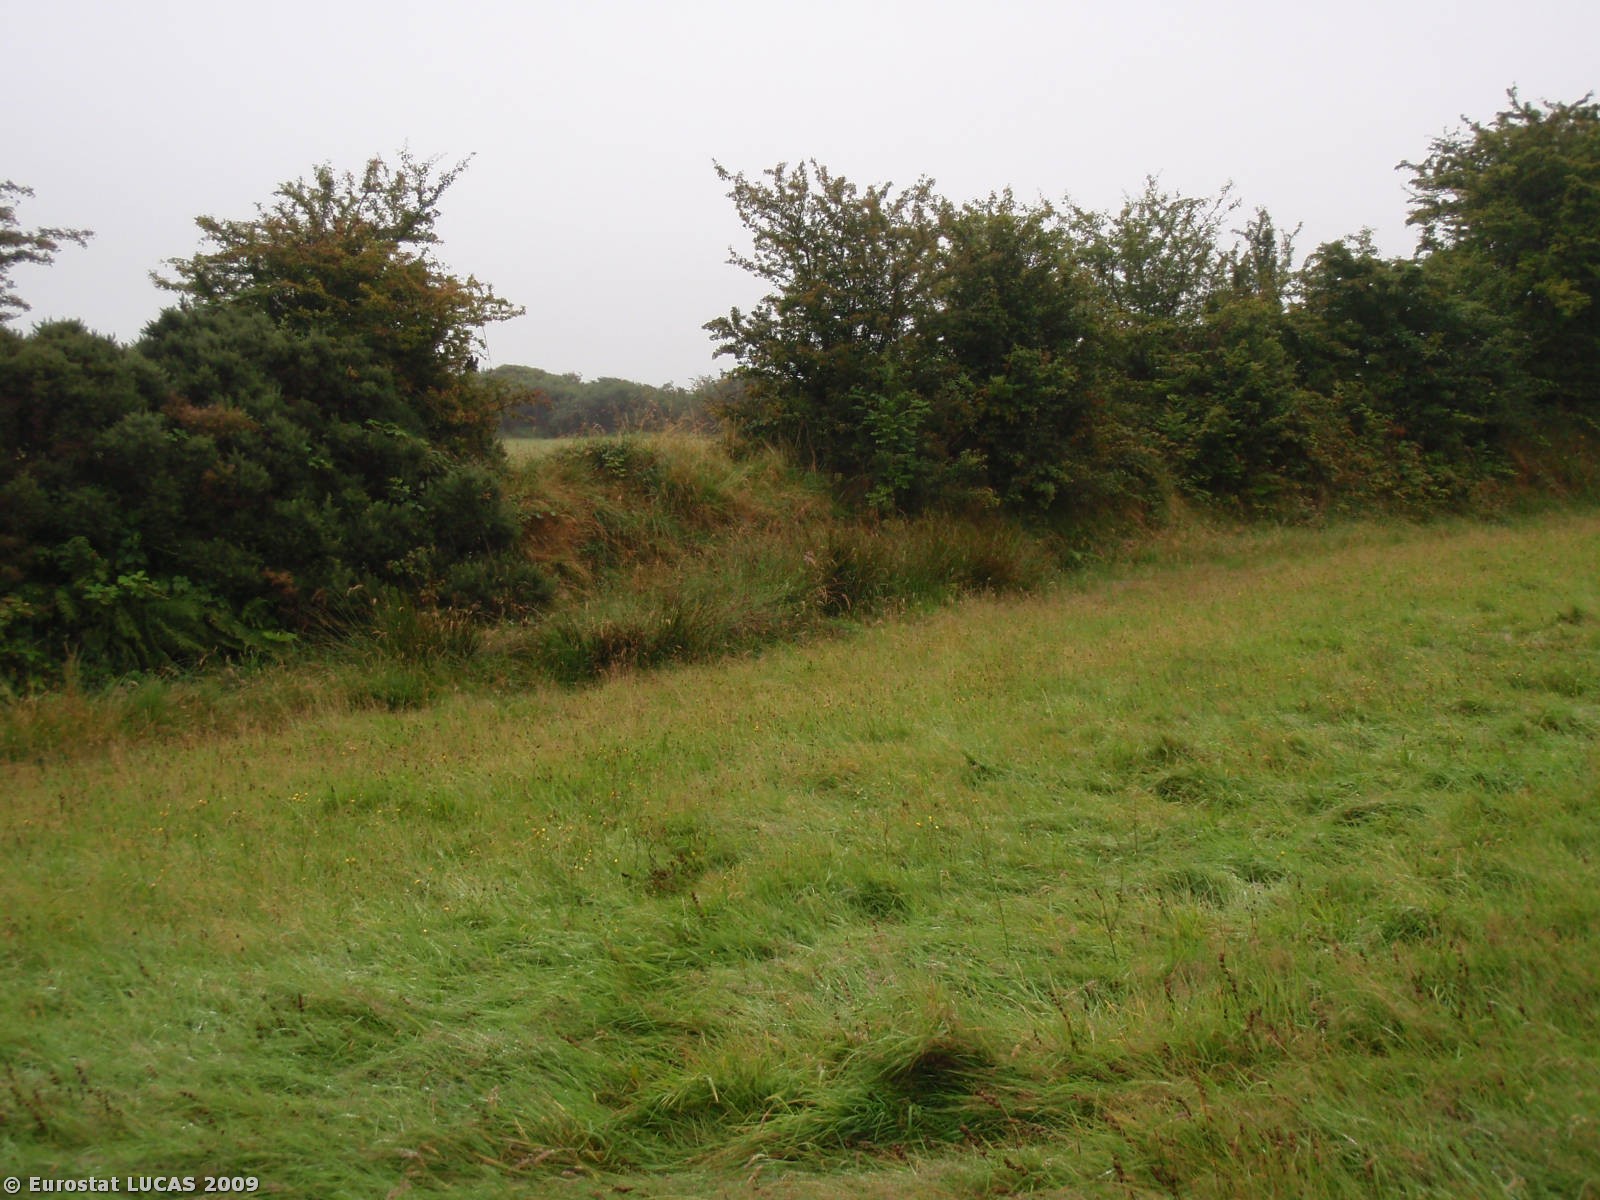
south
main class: Grassland
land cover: Grassland without tree/shrub cover
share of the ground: > 75 %
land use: Agriculture (excluding fallow land and kitchen gardens)
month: August
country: GB
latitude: 50.6311
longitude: -4.5689
